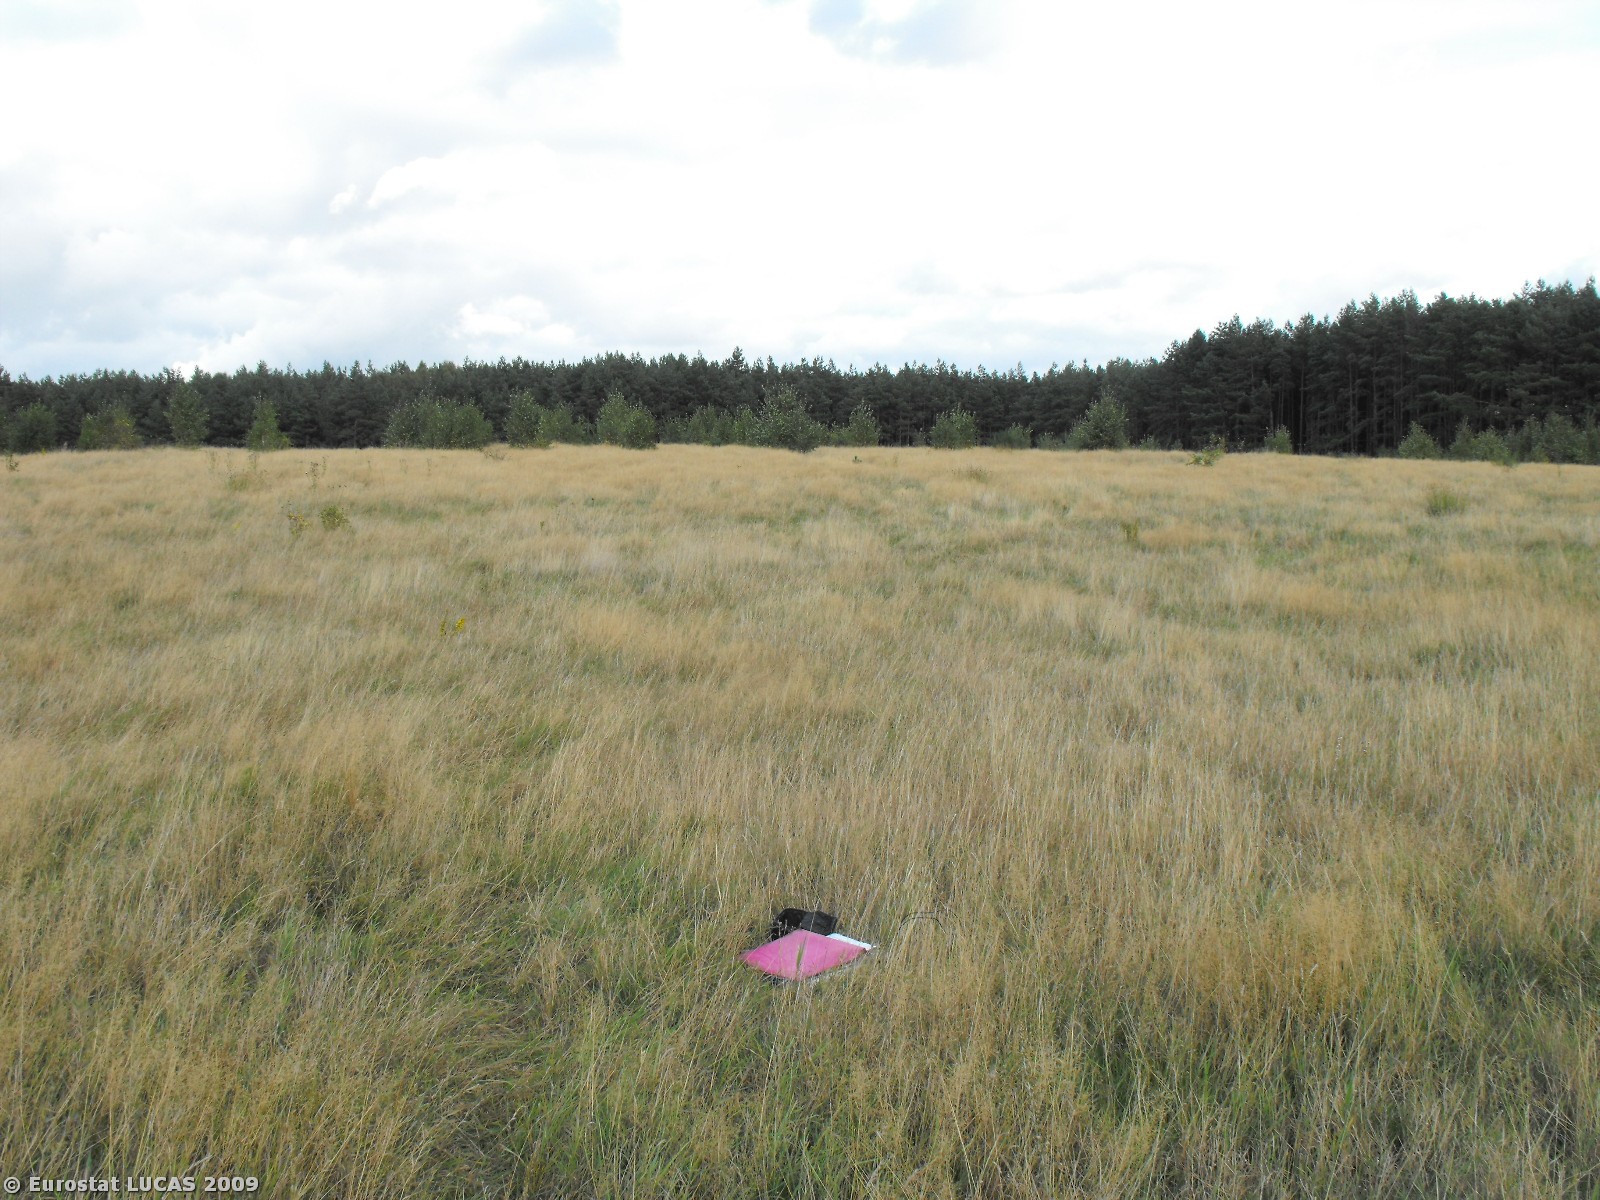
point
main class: Grassland
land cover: Grassland without tree/shrub cover
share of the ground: > 75 %
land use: Unused
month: September
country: PL
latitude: 54.2310
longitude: 16.6184
